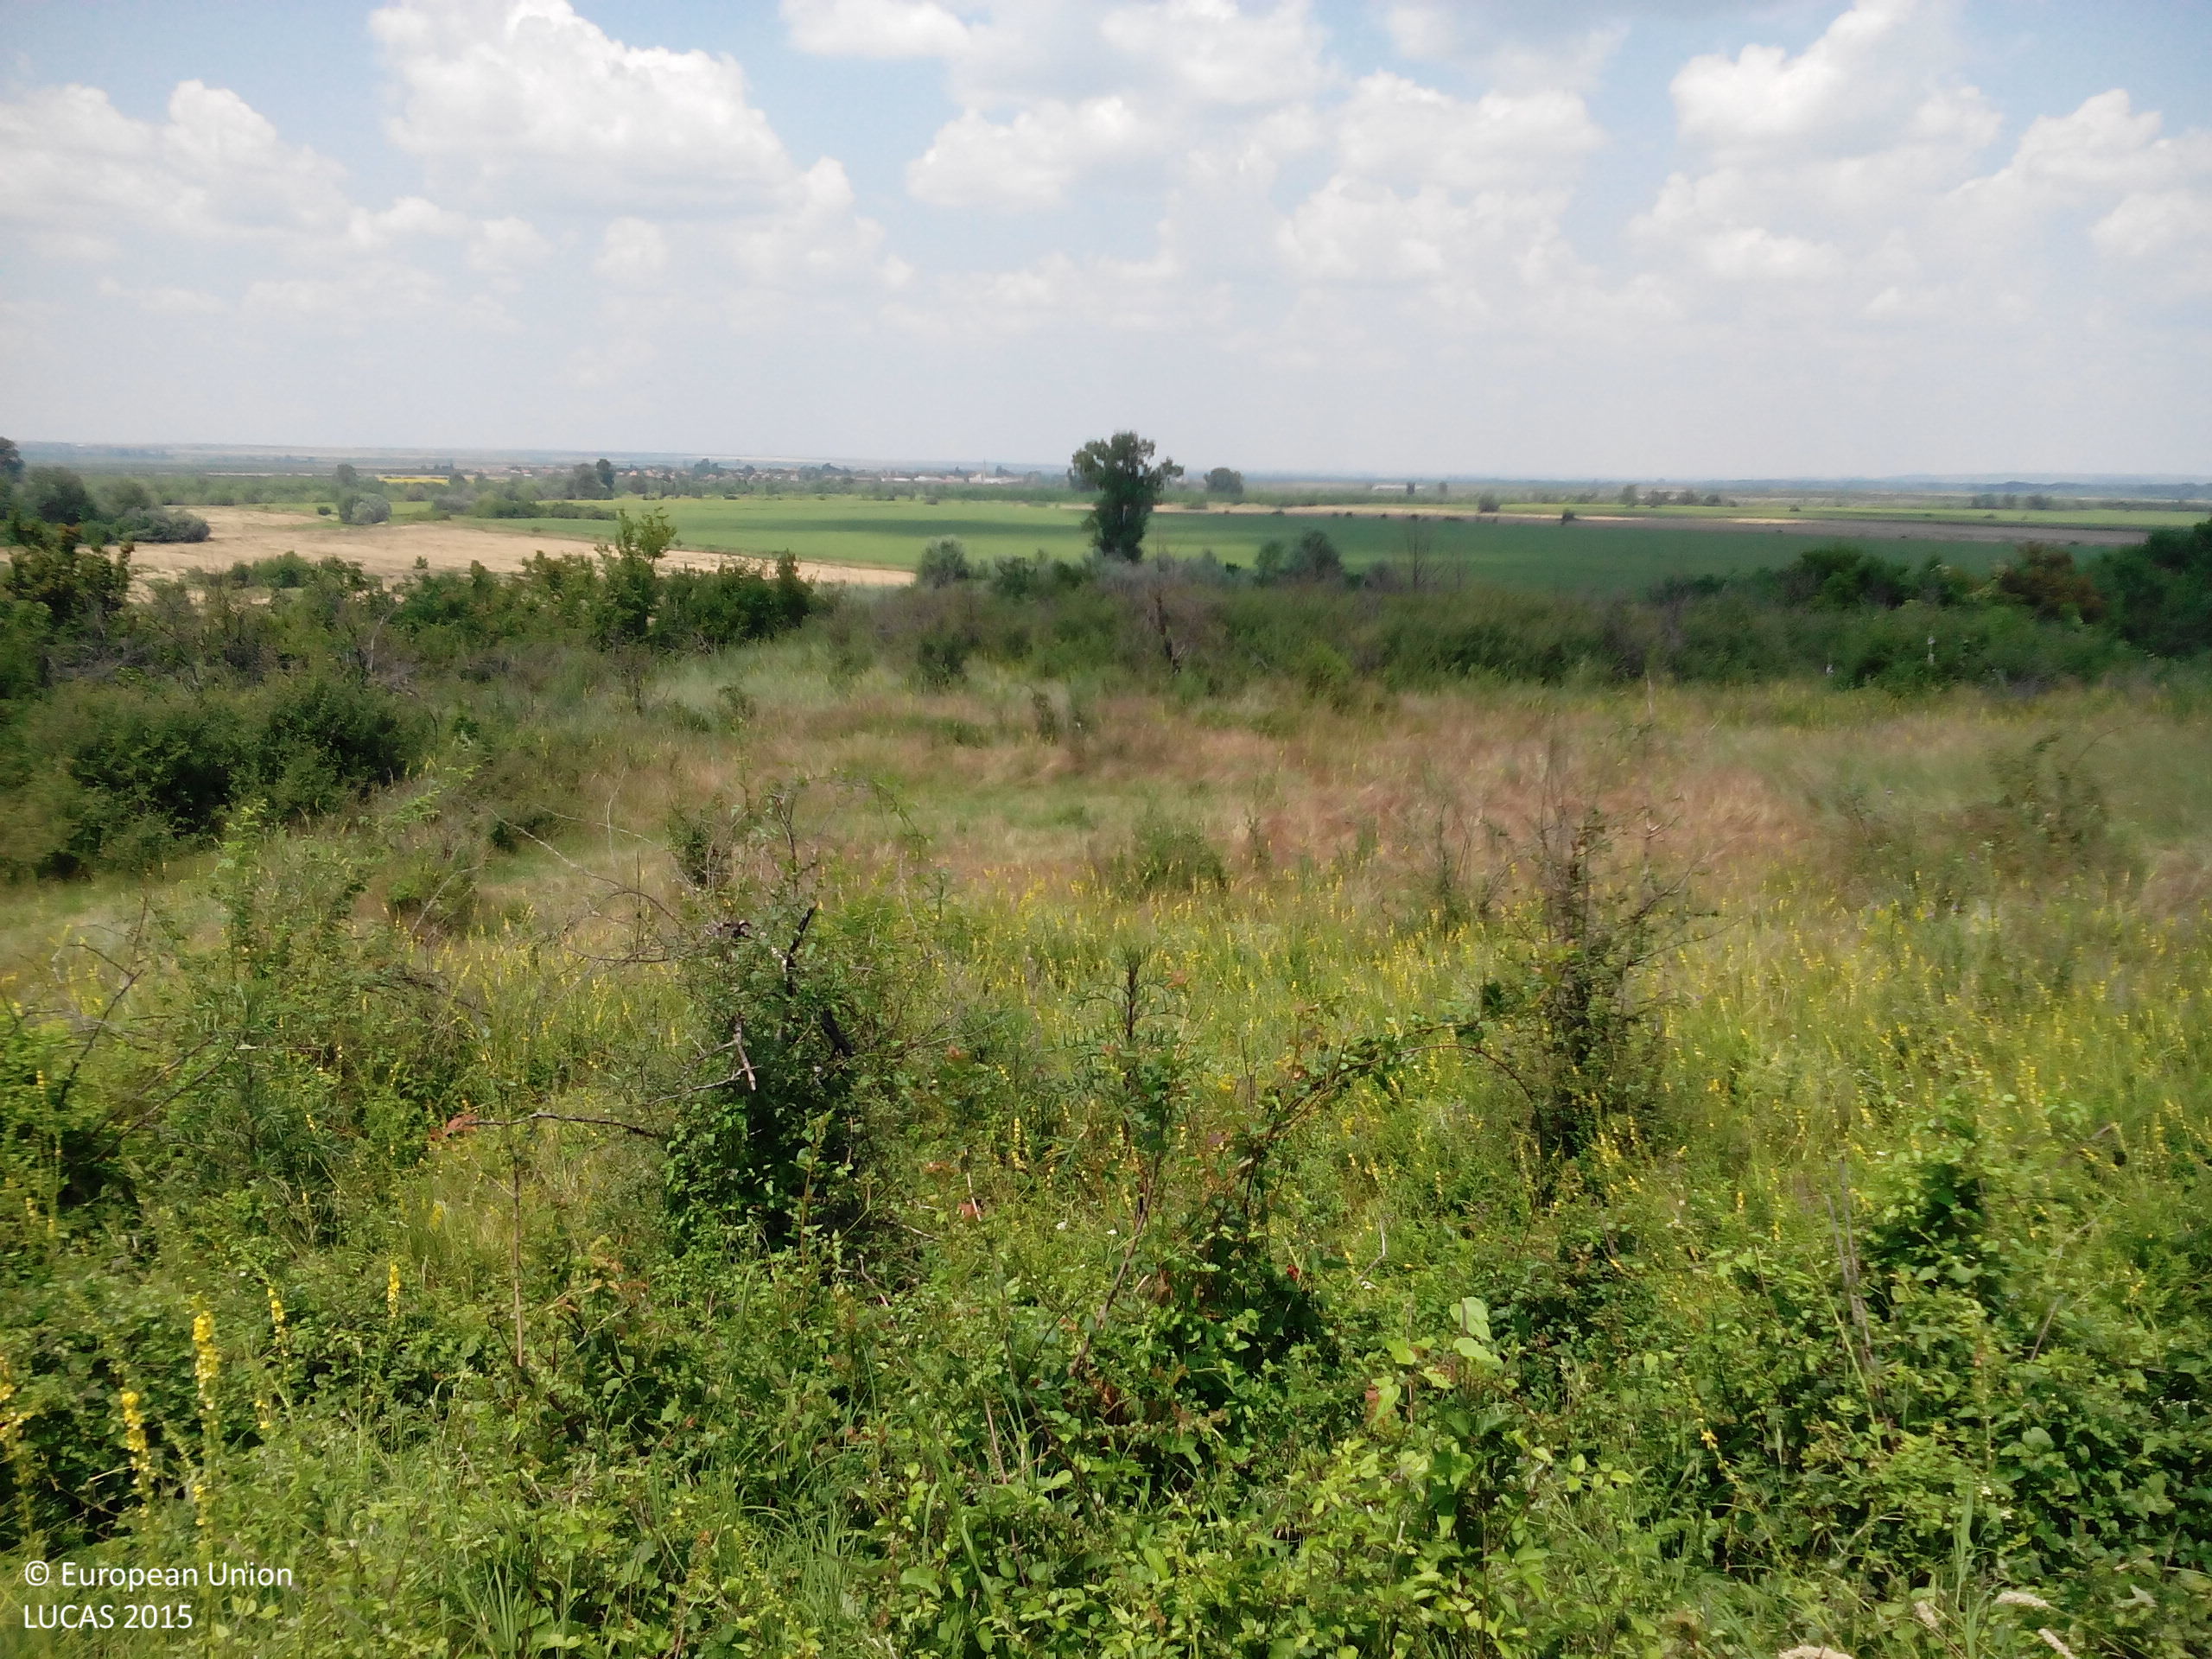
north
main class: Woodland
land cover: Broadleaved woodland
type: mesophytic deciduous forest
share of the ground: > 75 %
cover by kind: broadleaved forest trees 90 %, shrubs 5 %, herbaceous plants 5 %
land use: Forestry
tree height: > 5 m
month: July
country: BG
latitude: 43.3669
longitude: 24.2095
